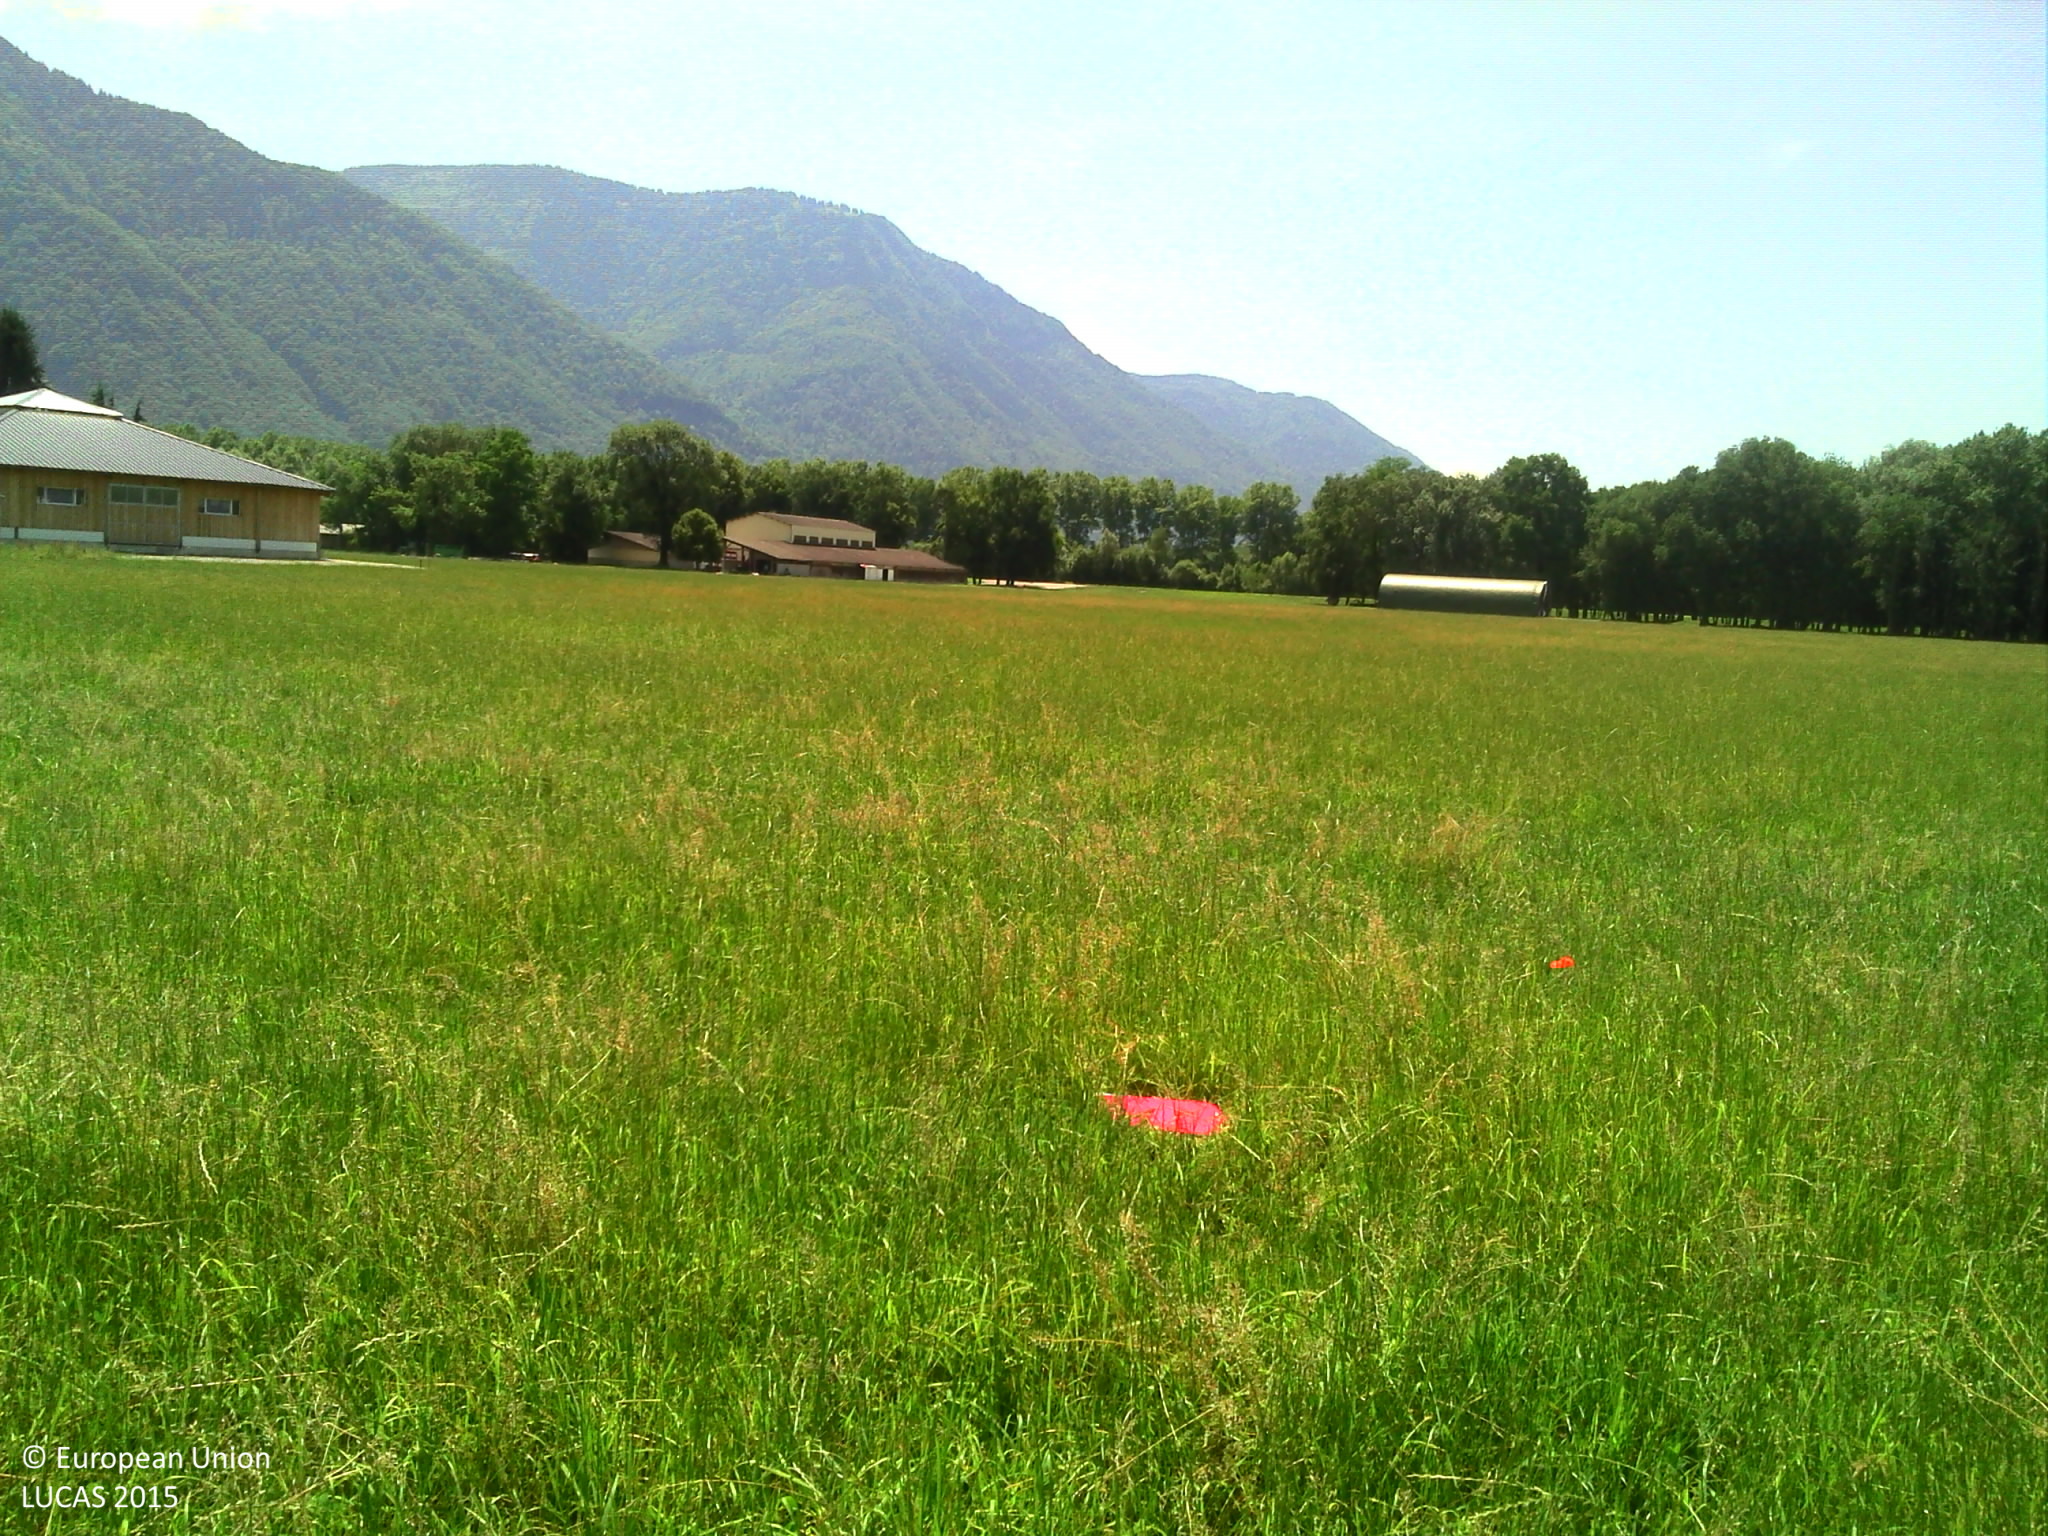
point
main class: Grassland
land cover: Grassland without tree/shrub cover
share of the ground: > 75 %
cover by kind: herbaceous plants 100 %
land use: Agriculture (excluding fallow land and kitchen gardens)
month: June
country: FR
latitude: 45.5632
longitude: 6.2250
